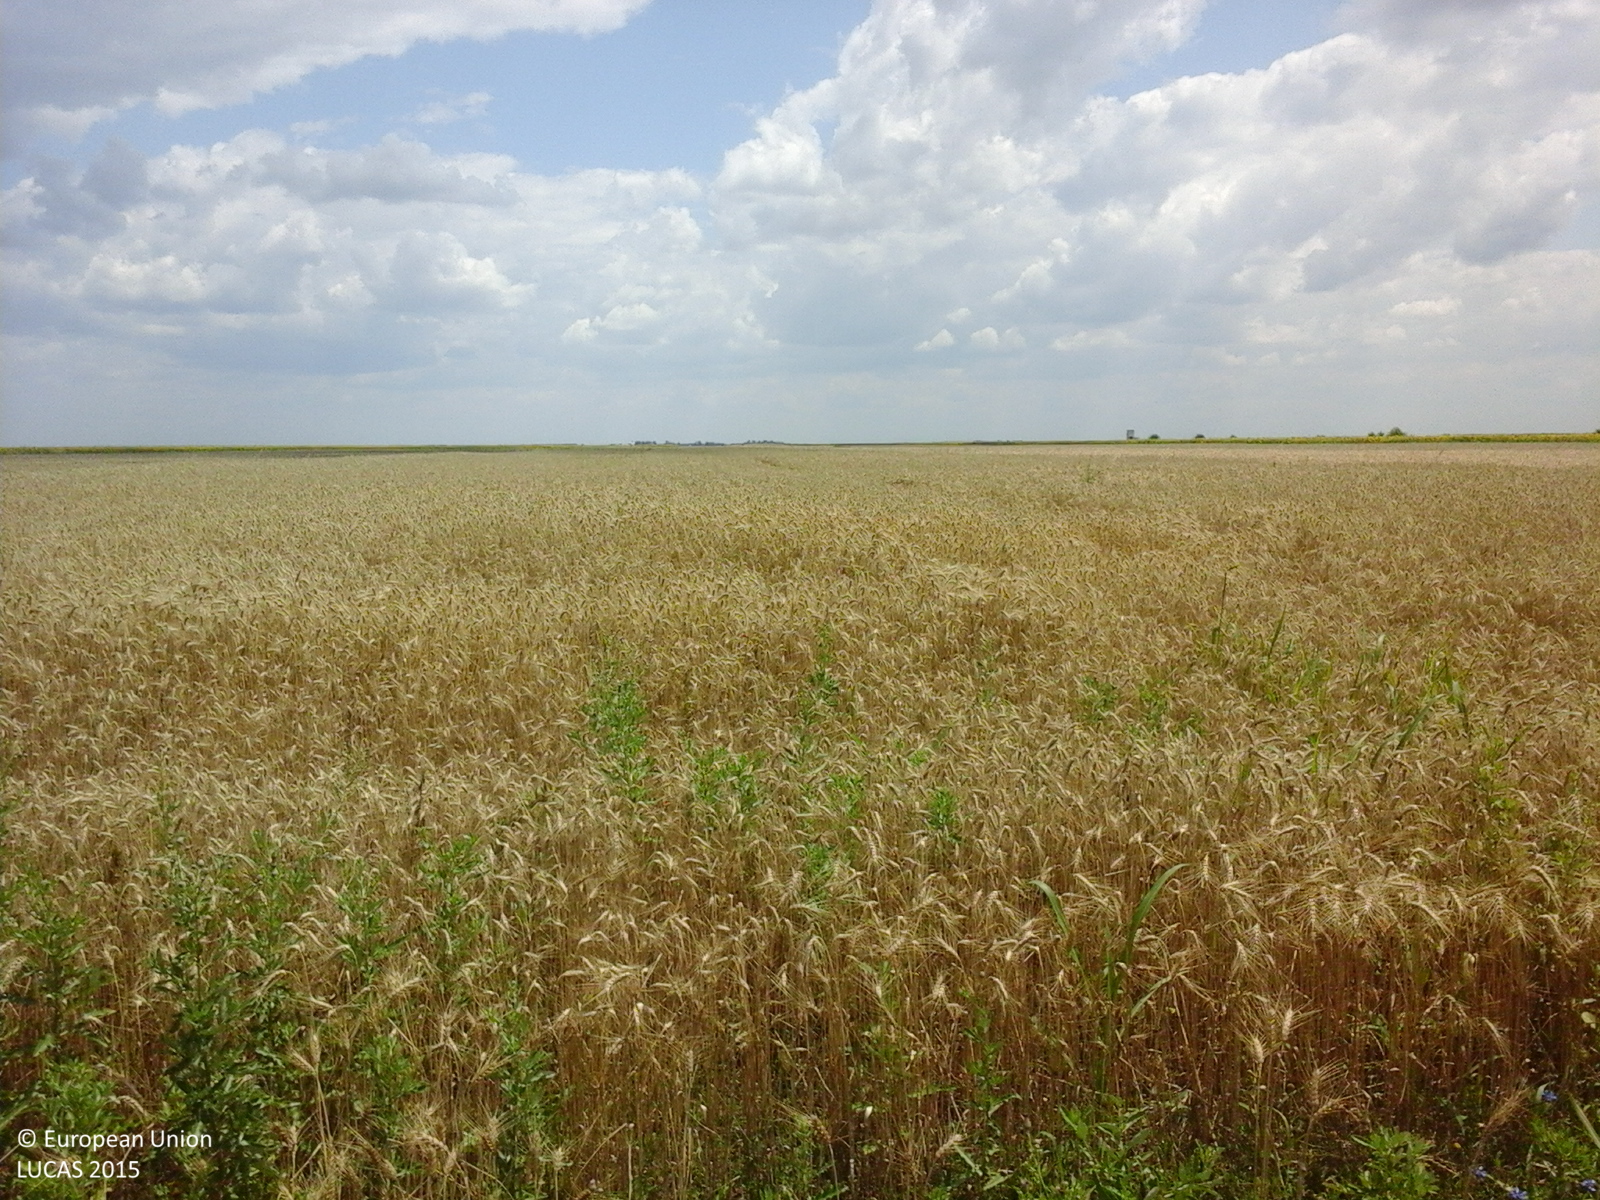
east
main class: Cropland
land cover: Common wheat
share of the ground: > 75 %
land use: Agriculture (excluding fallow land and kitchen gardens)
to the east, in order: Common wheat; Grass margins; Tracks; Grass margins; Common wheat
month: July
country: RO
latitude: 44.0036
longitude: 24.8777
